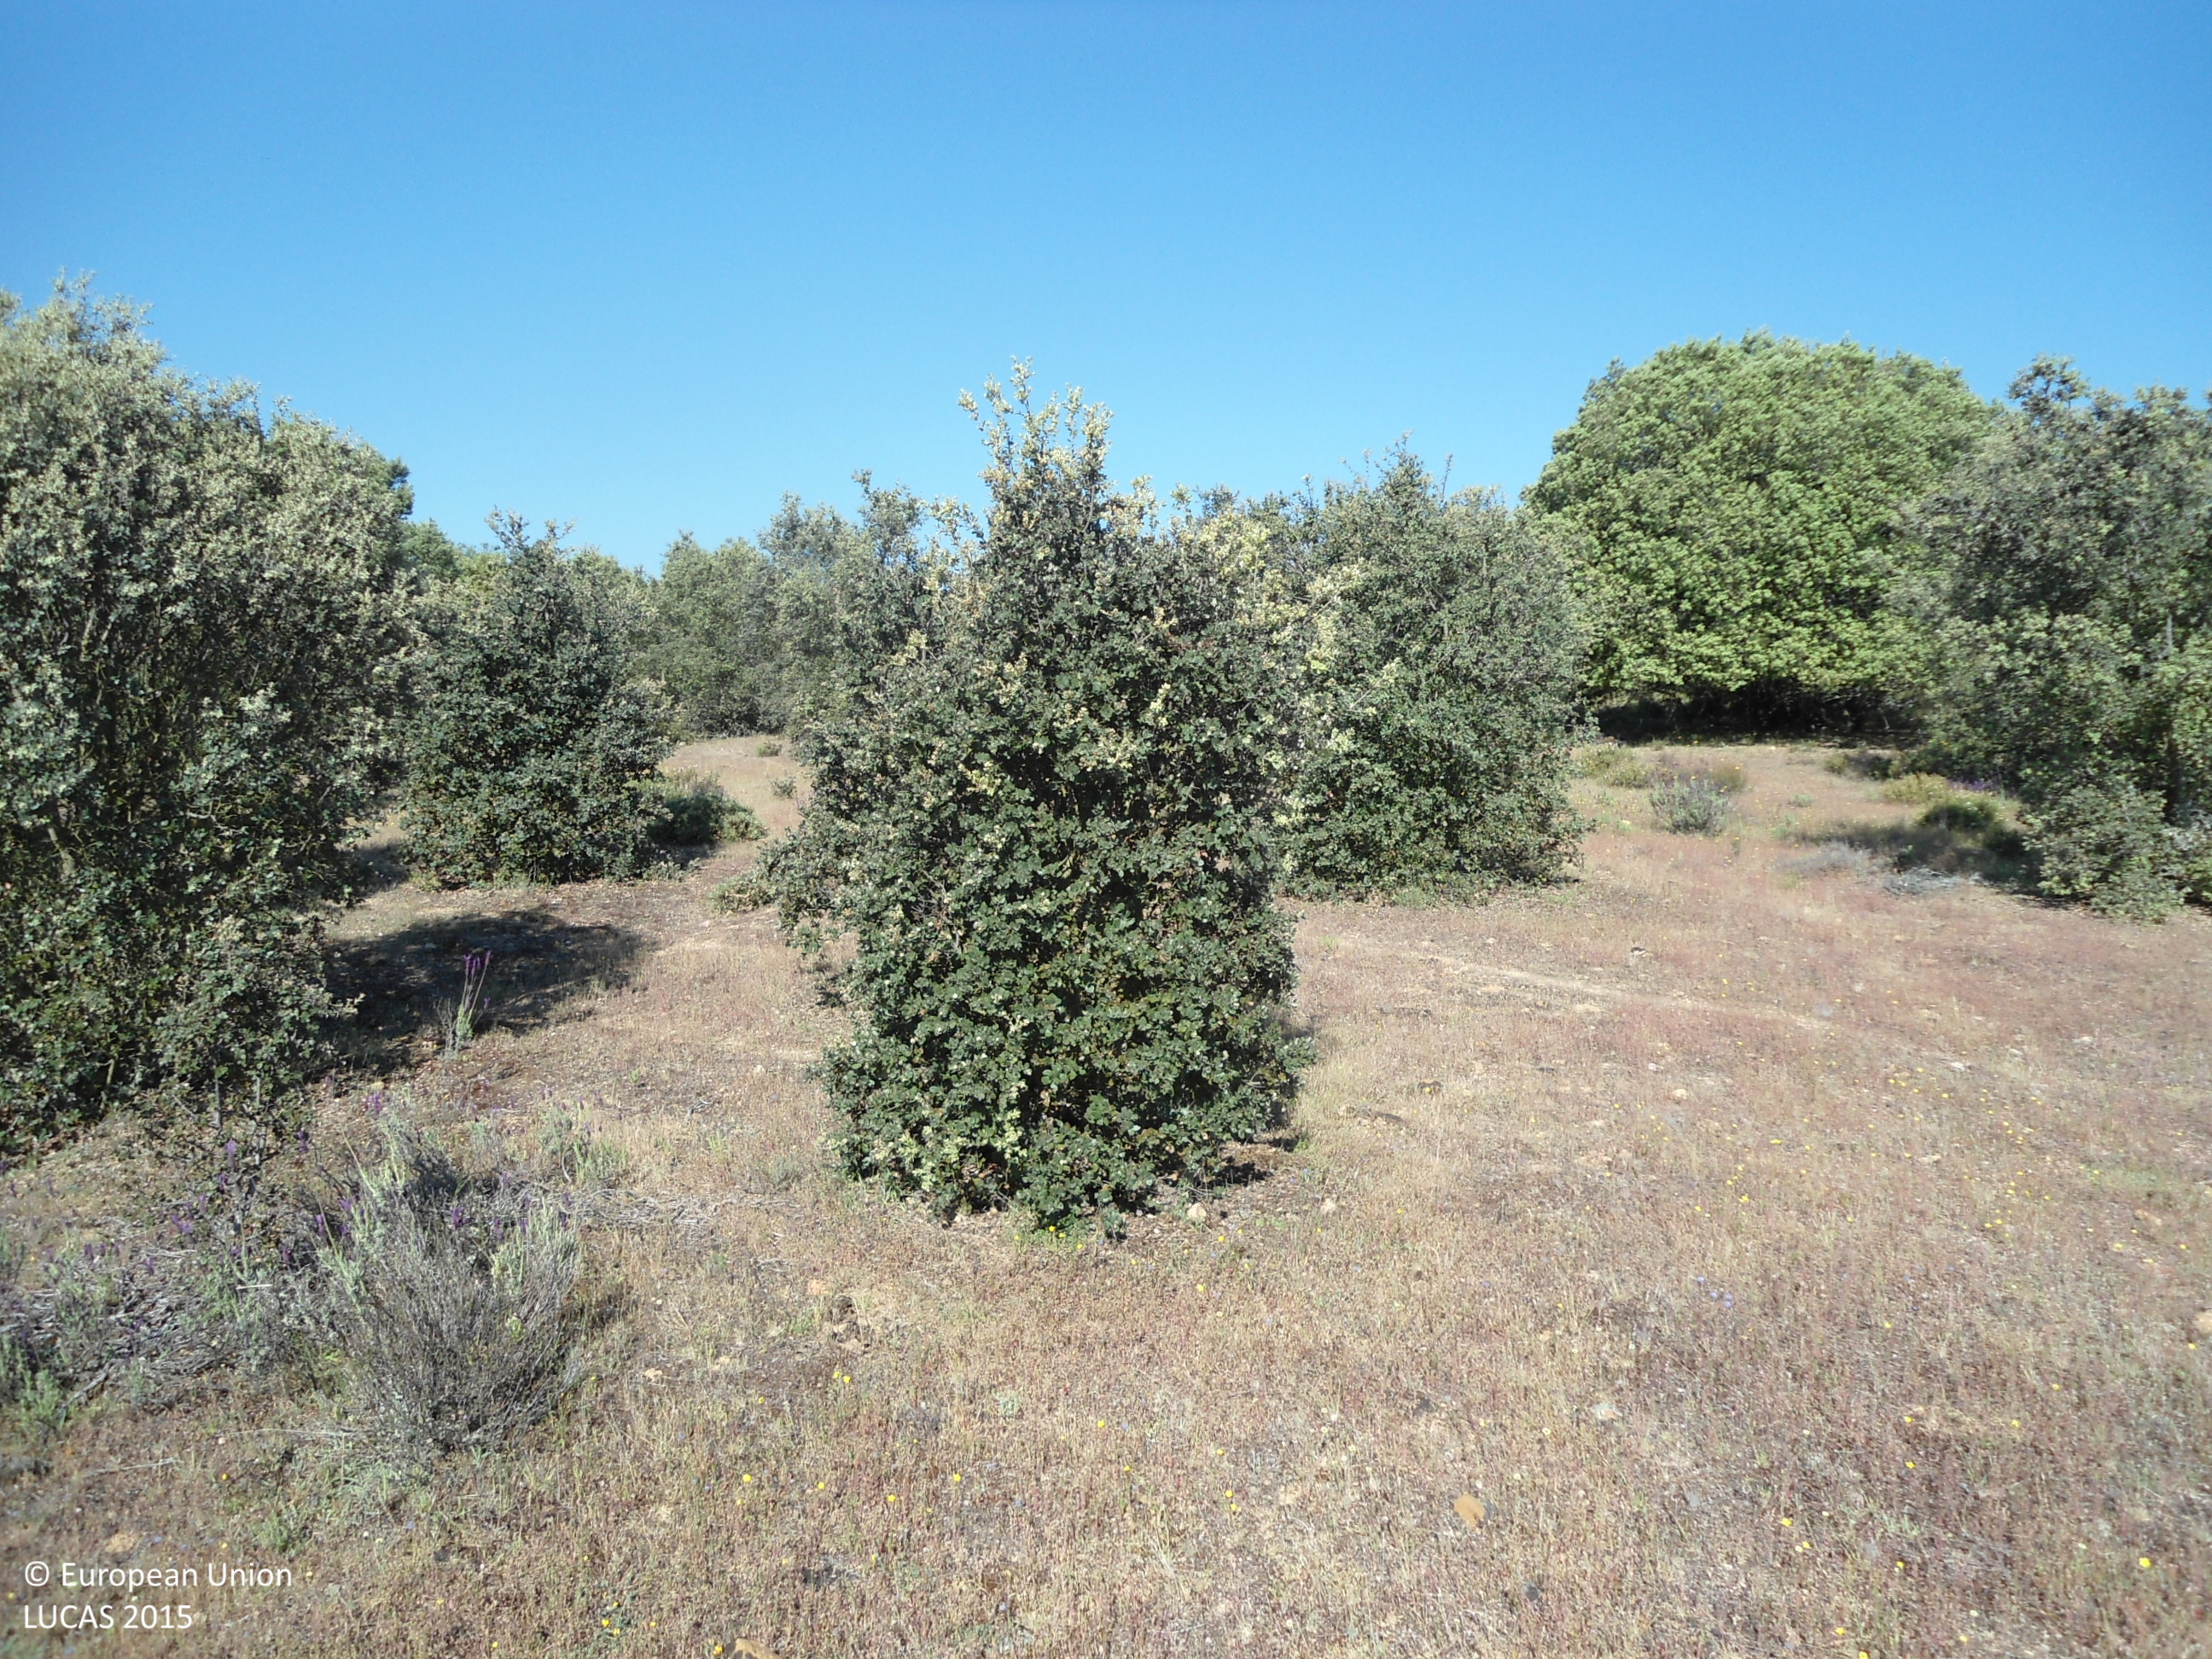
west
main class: Grassland
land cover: Grassland with sparse tree/shrub cover
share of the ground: 50 - 75 %
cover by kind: herbaceous plants 85 %, shrubs 10 %, broadleaved forest trees 5 %
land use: Agriculture (excluding fallow land and kitchen gardens)
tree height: < 5 m
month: June
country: ES
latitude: 42.0335
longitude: -6.2297
